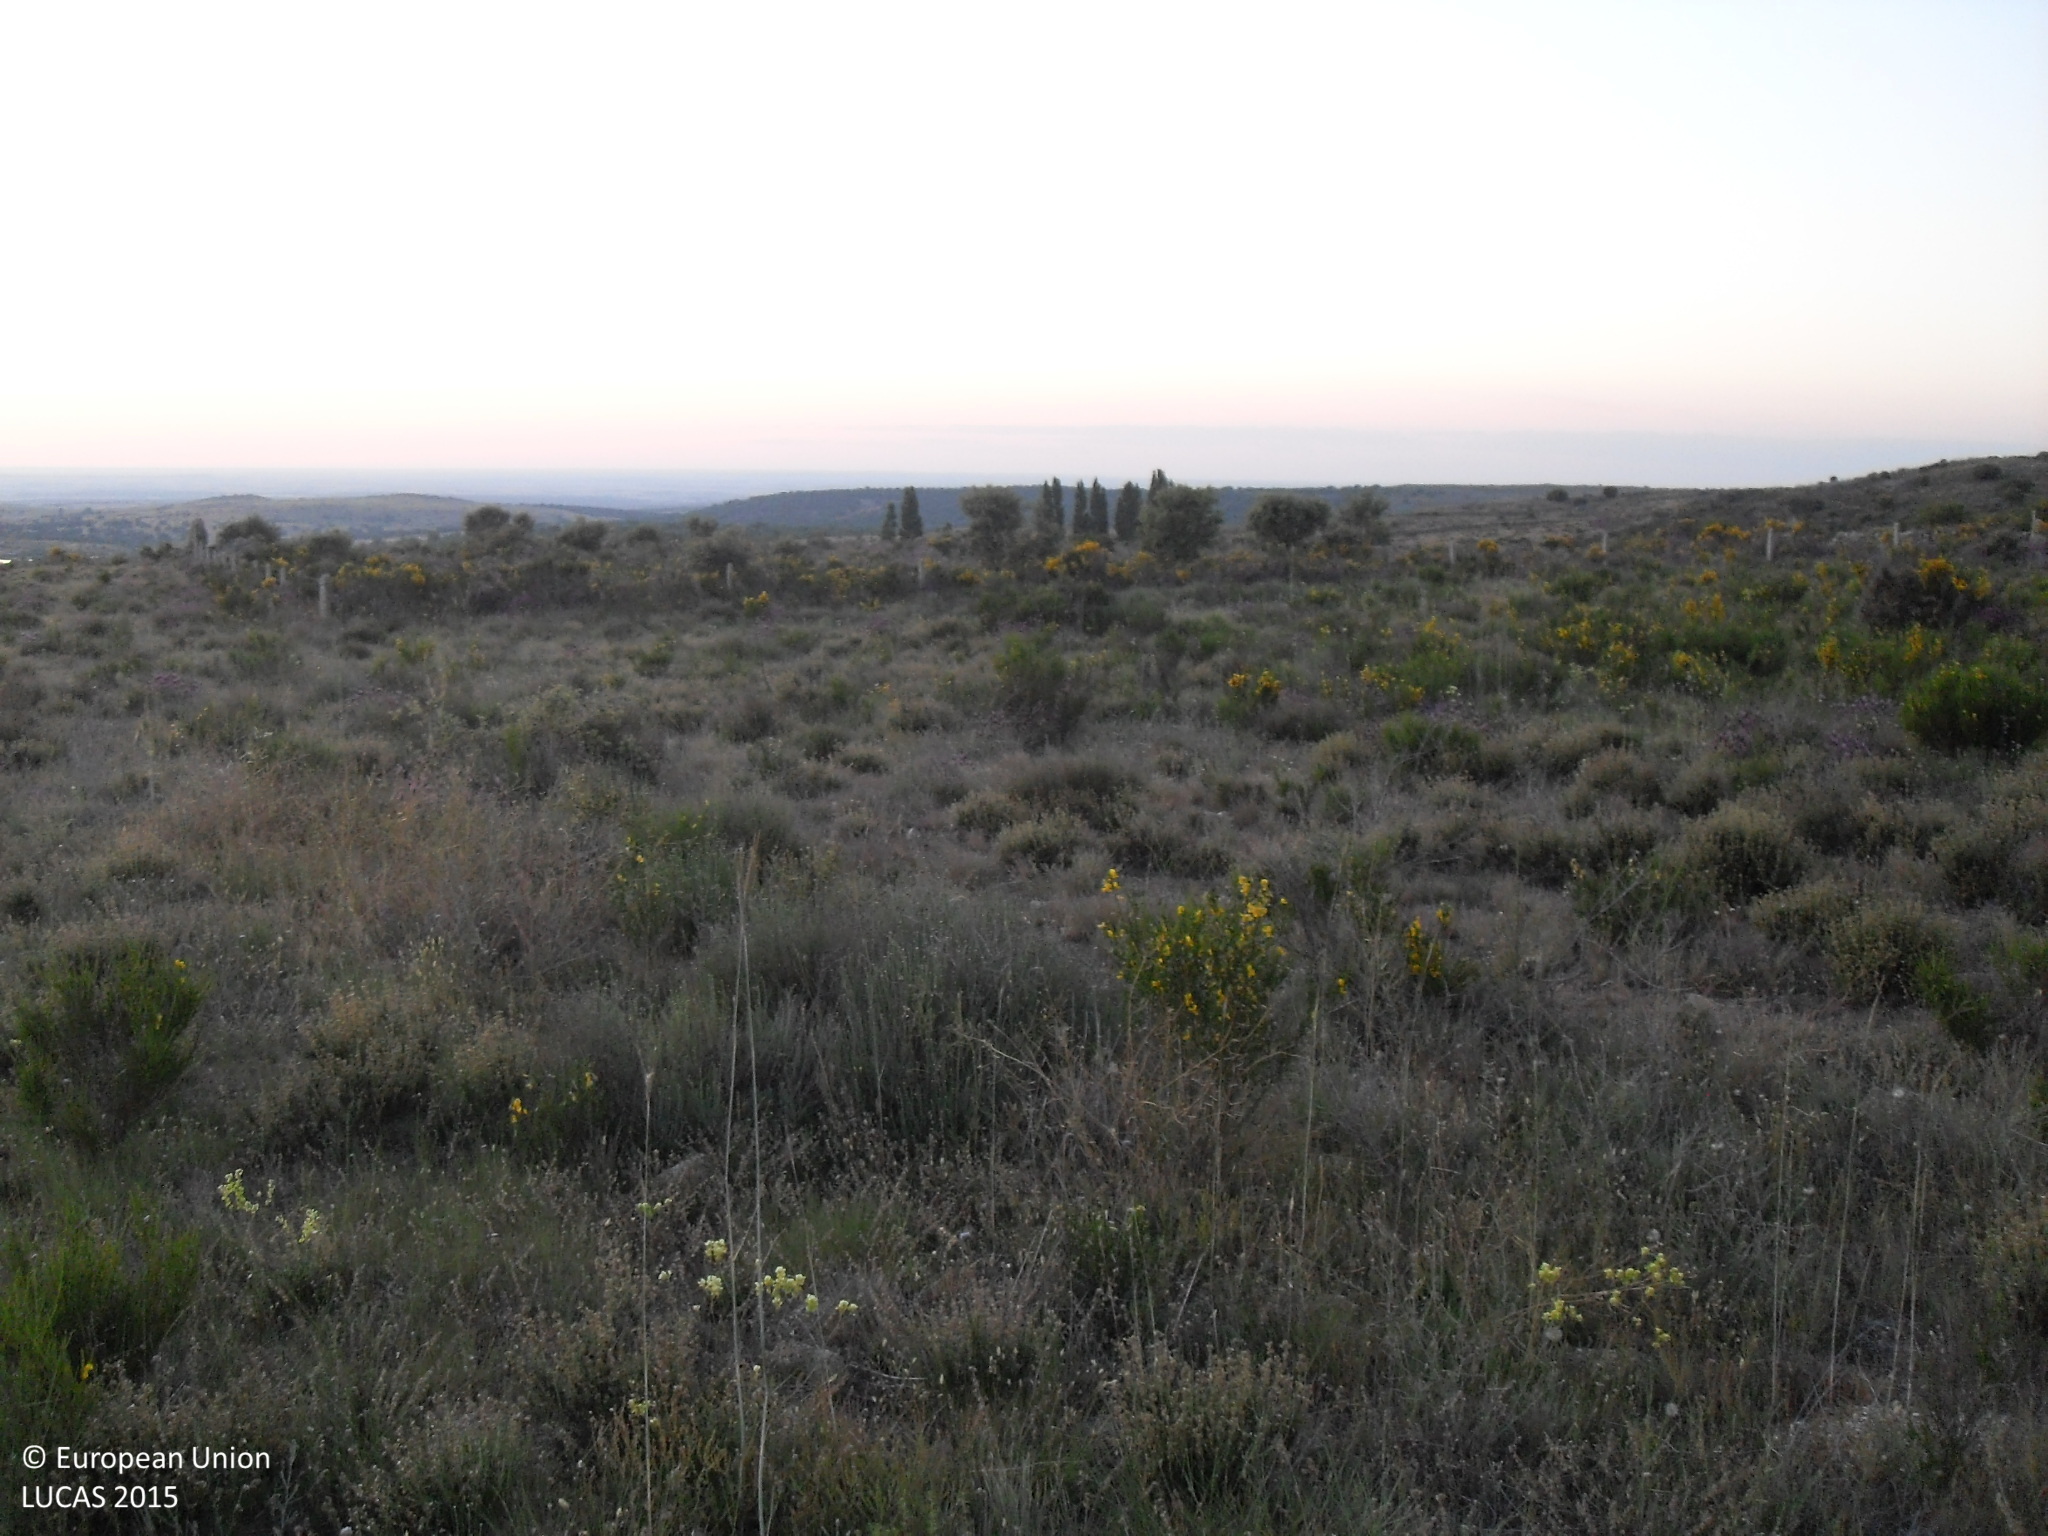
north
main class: Grassland
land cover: Grassland without tree/shrub cover
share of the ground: > 75 %
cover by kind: herbaceous plants 100 %
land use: Agriculture (excluding fallow land and kitchen gardens)
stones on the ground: < 10 %
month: May
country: ES
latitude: 40.5674
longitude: -5.2896
